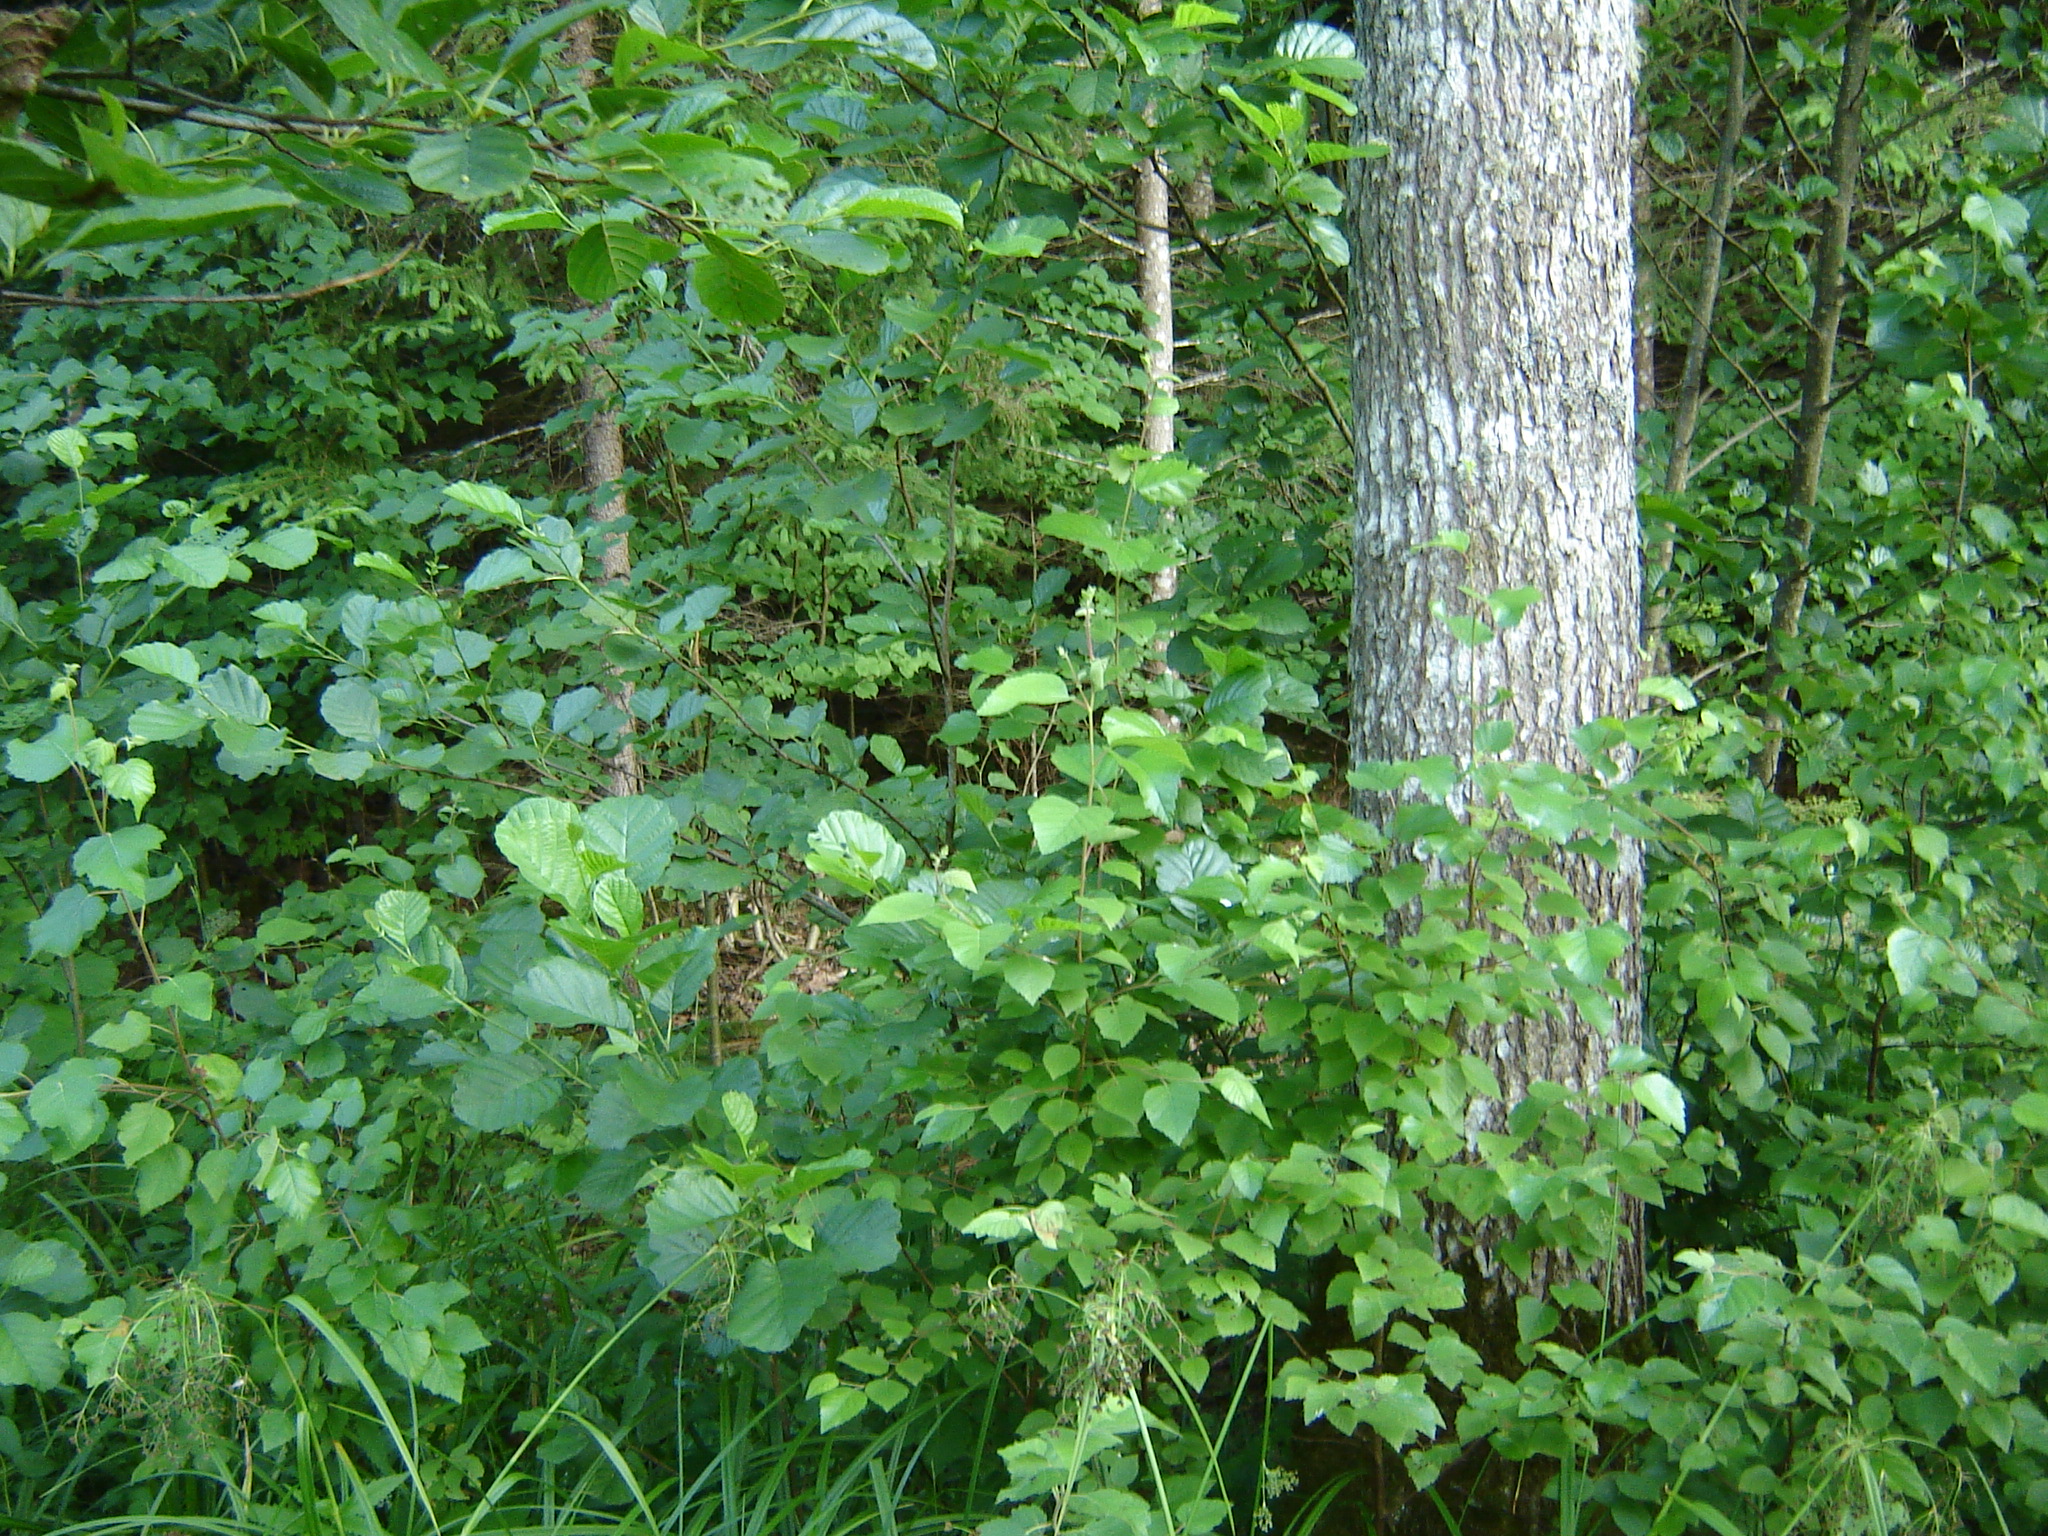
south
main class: Woodland
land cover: Broadleaved woodland
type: non-riverine alder, birch or aspen forest
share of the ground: 50 - 75 %
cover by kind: broadleaved forest trees 70 %, herbaceous plants 30 %
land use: Forestry
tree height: < 5 m
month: July
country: LT
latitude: 55.4485
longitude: 25.5729
